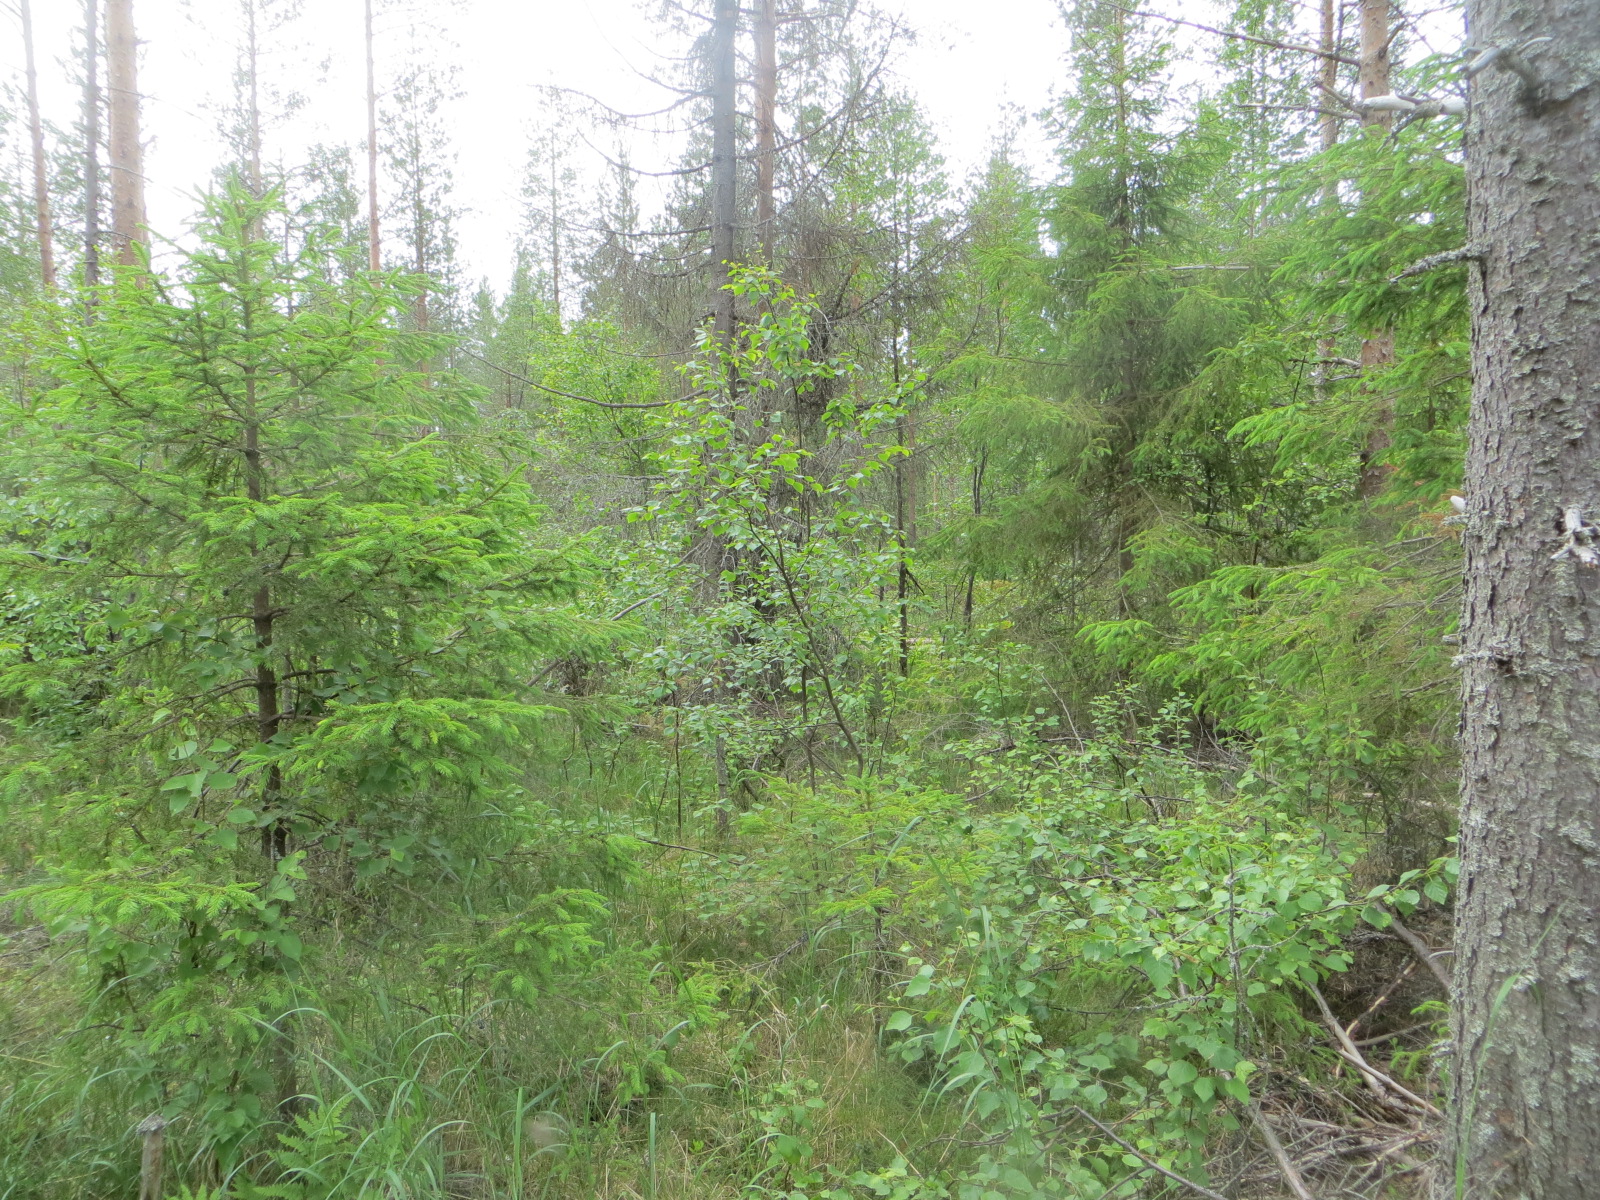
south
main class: Woodland
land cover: Pine dominated mixed woodland
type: boreal forest
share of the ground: 50 - 75 %
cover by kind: coniferous forest trees 40 %, shrubs 40 %, broadleaved forest trees 20 %
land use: Forestry
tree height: > 5 m
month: July
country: FI
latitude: 65.3820
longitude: 26.1215
